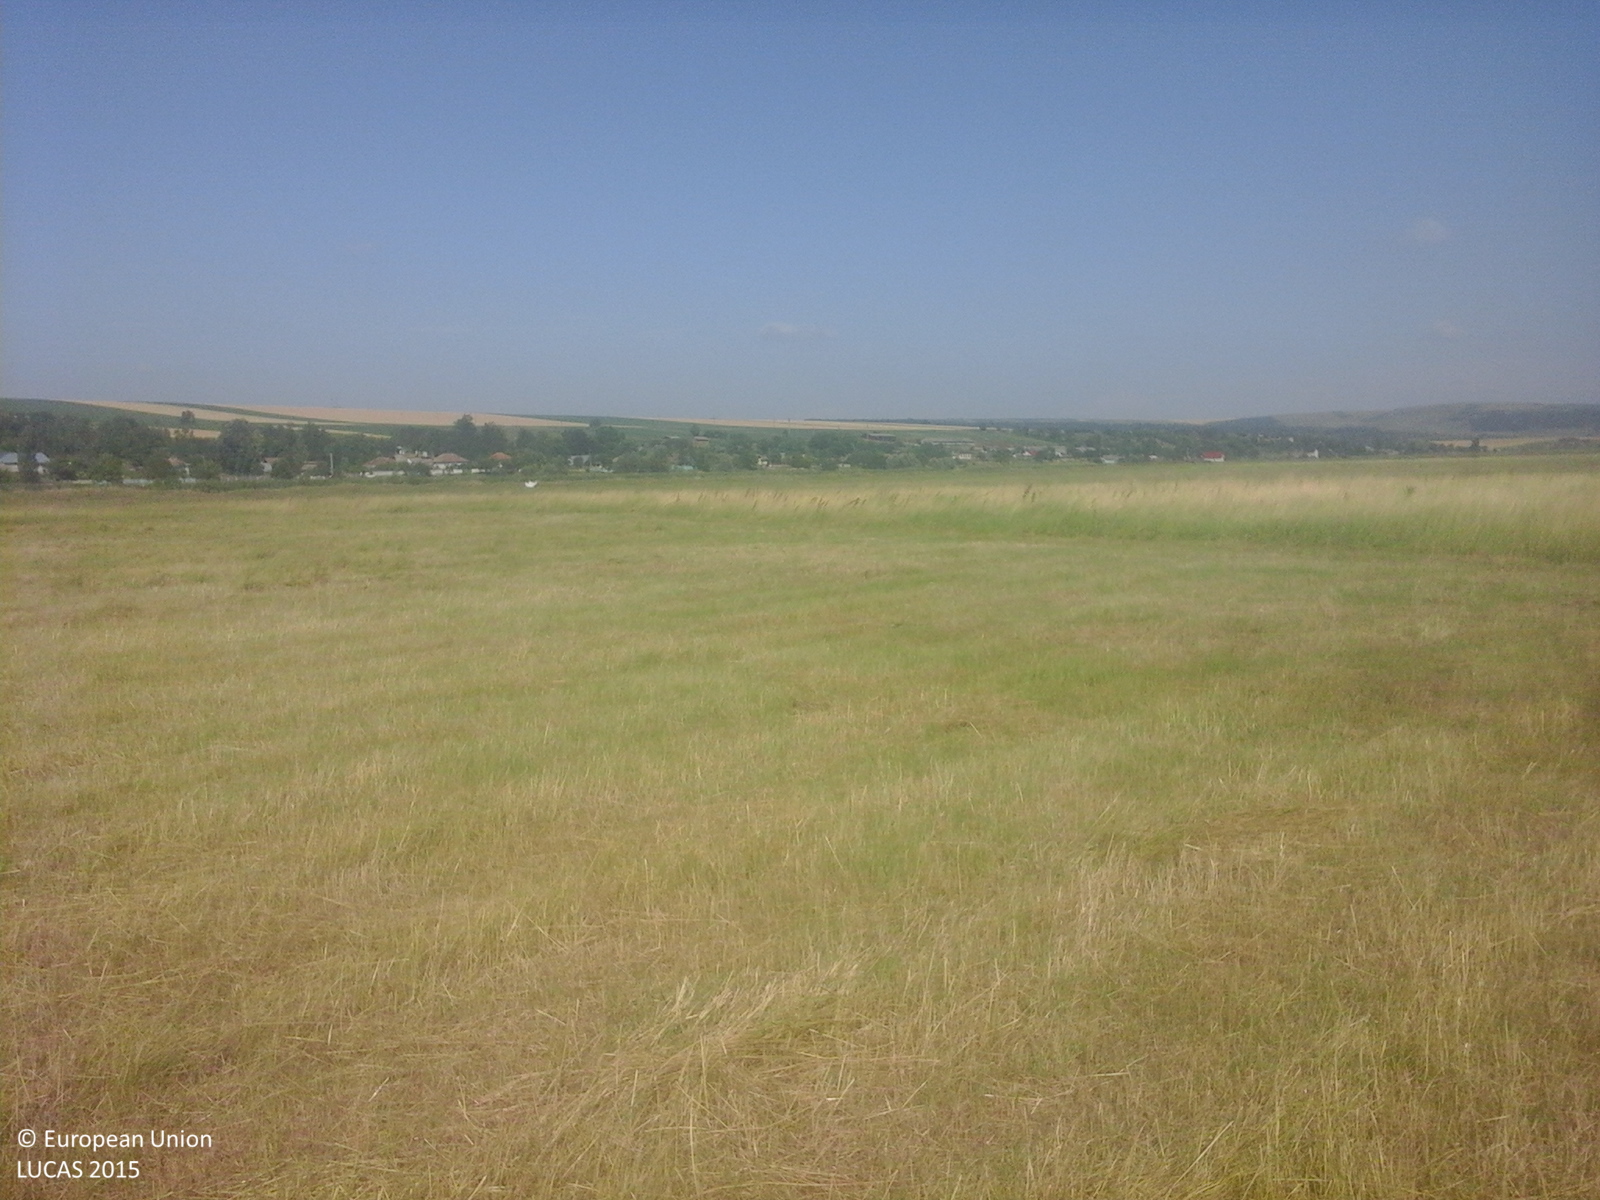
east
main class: Grassland
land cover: Grassland without tree/shrub cover
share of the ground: > 75 %
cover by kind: herbaceous plants 100 %
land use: Agriculture (excluding fallow land and kitchen gardens)
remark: Harvested field
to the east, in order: Grassland without tree/shrub cover; Ditches and canals; Grassland without tree/shrub cover
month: June
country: RO
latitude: 46.8042
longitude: 27.5284
